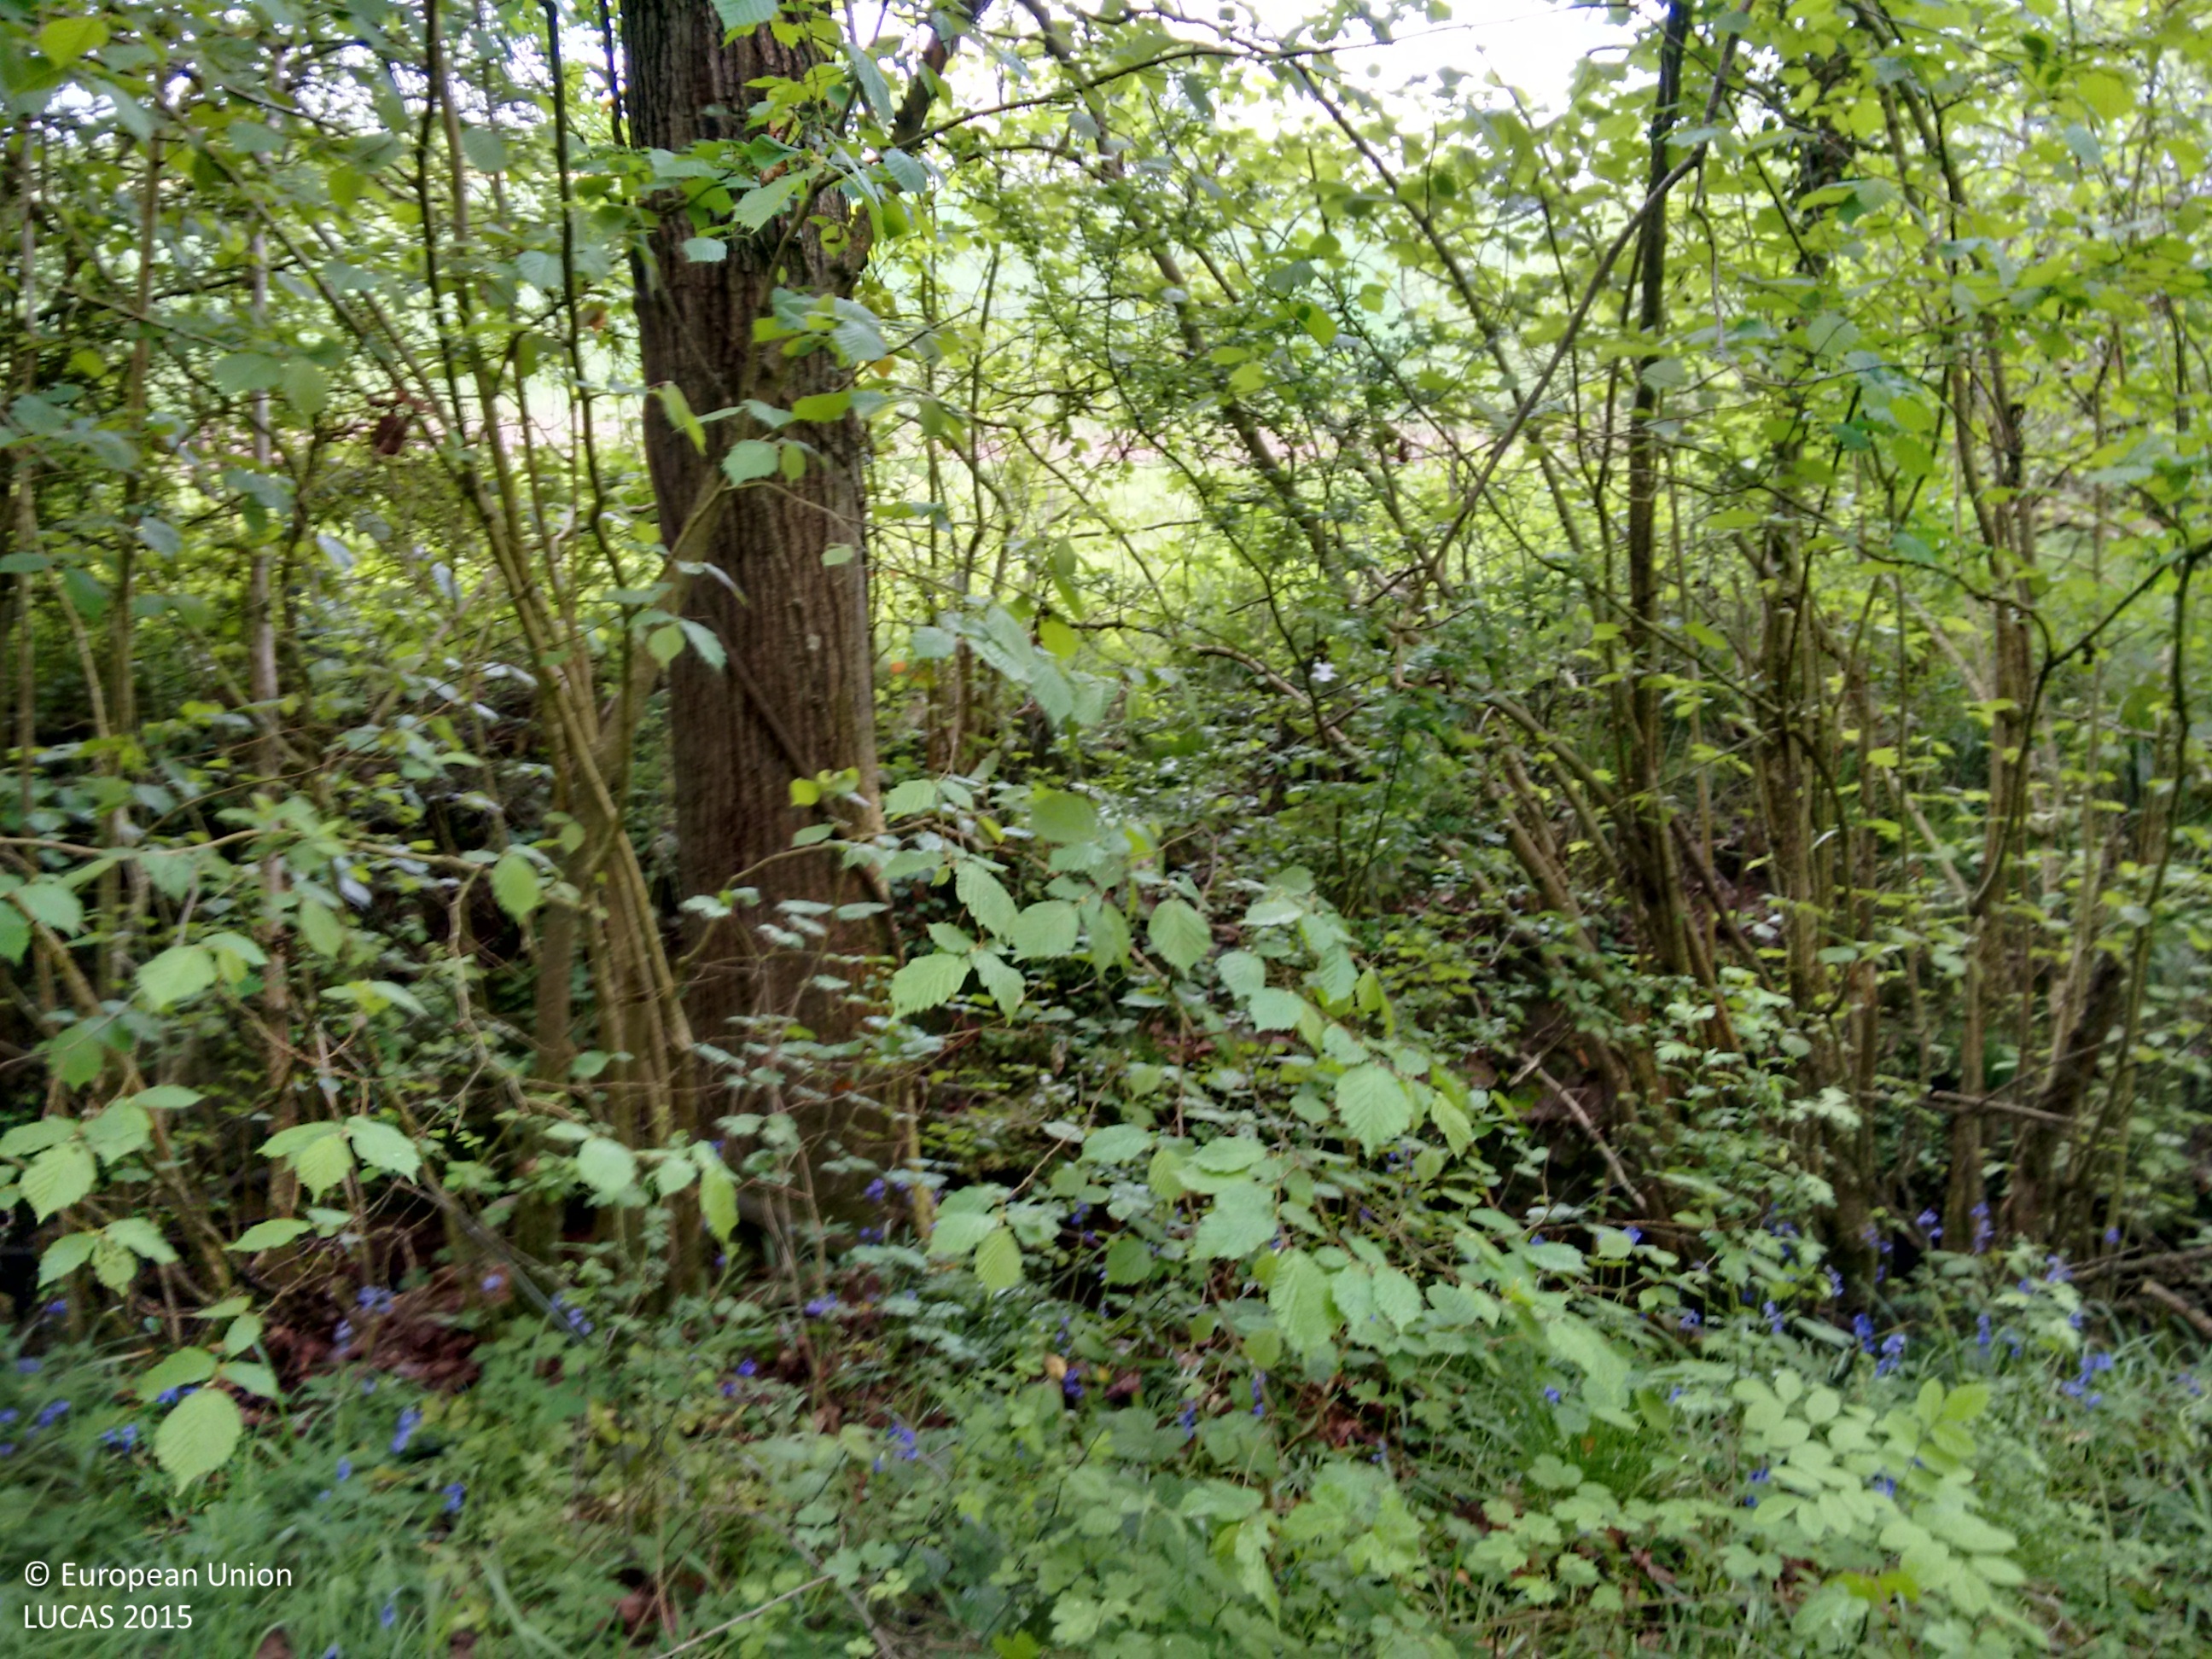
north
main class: Woodland
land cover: Broadleaved woodland
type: mesophytic deciduous forest
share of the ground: > 75 %
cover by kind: broadleaved forest trees 85 %, herbaceous plants 10 %, shrubs 5 %
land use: Semi-natural and natural areas not in use
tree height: > 5 m
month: May
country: GB
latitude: 52.2924
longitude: -2.1865
